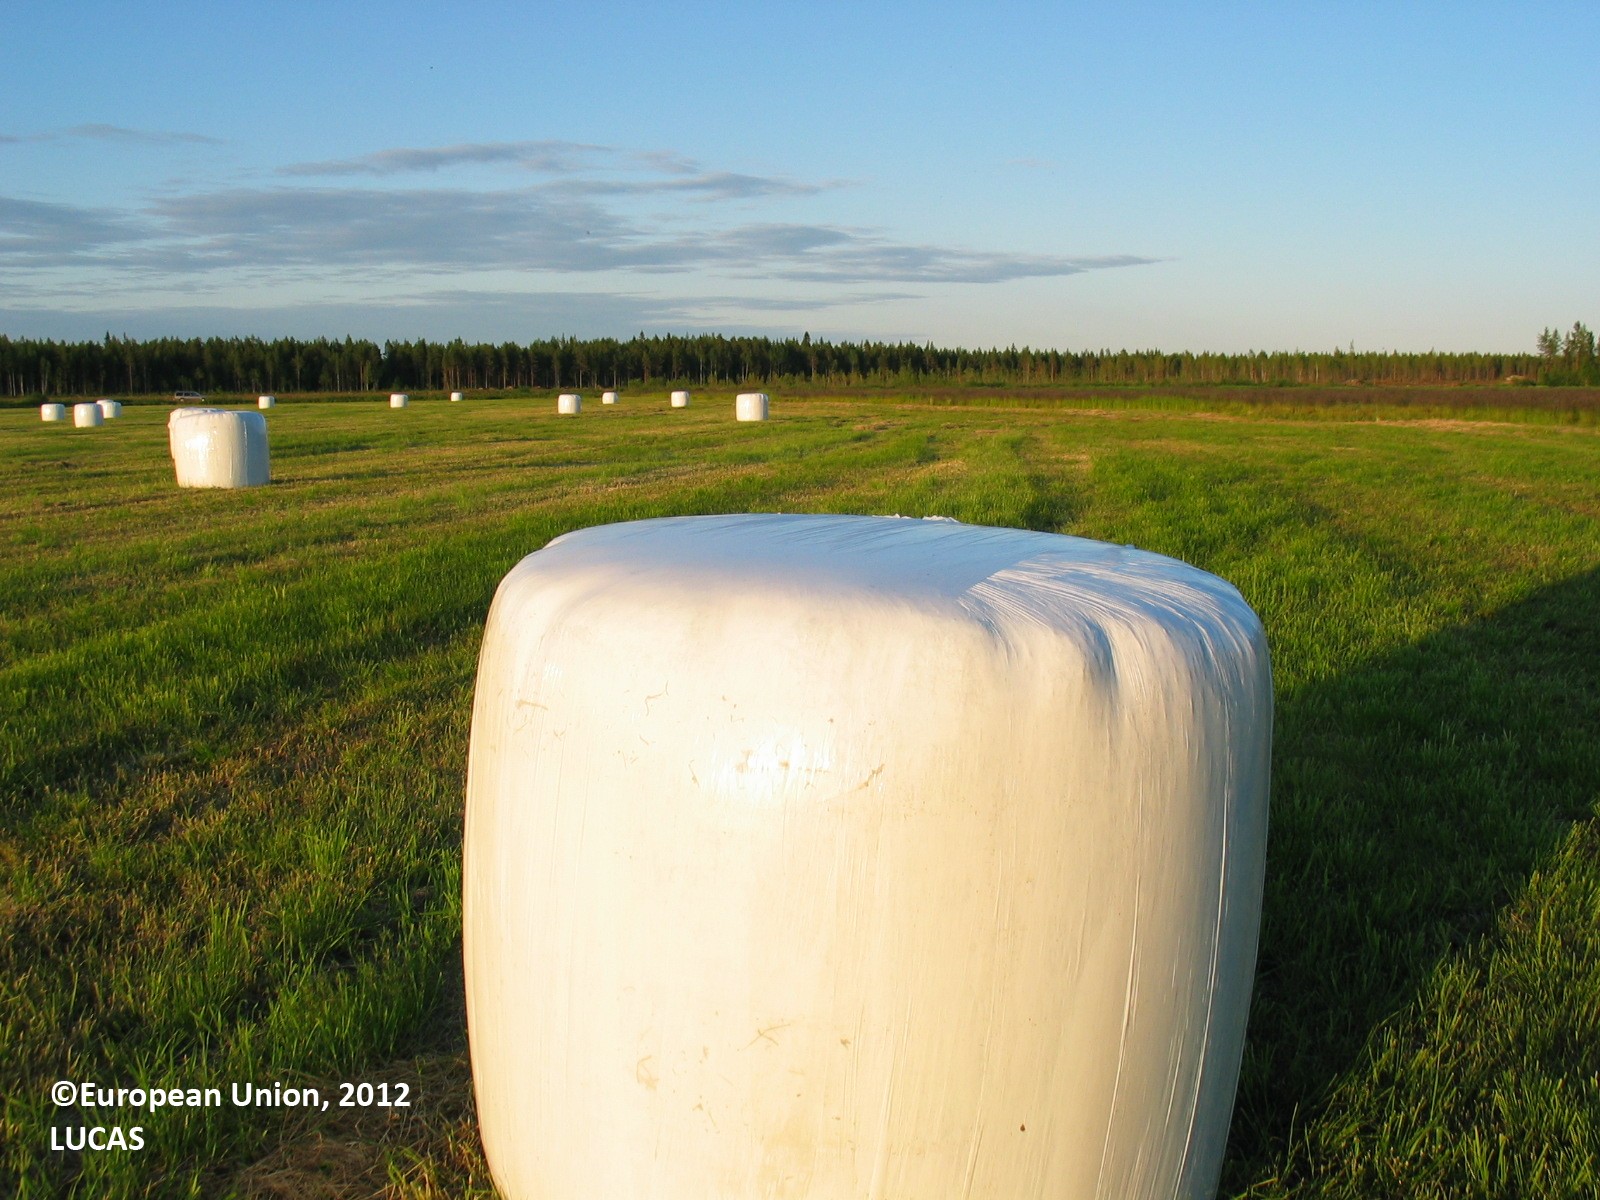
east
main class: Cropland
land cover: Temporary grasslands
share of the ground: > 75 %
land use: Agriculture (excluding fallow land and kitchen gardens)
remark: Harvested field
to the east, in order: Temporary grasslands; Grassland with sparse tree/shrub cover; Tracks; Grassland with sparse tree/shrub cover; Barley
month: July
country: FI
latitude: 64.4156
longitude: 26.3202
